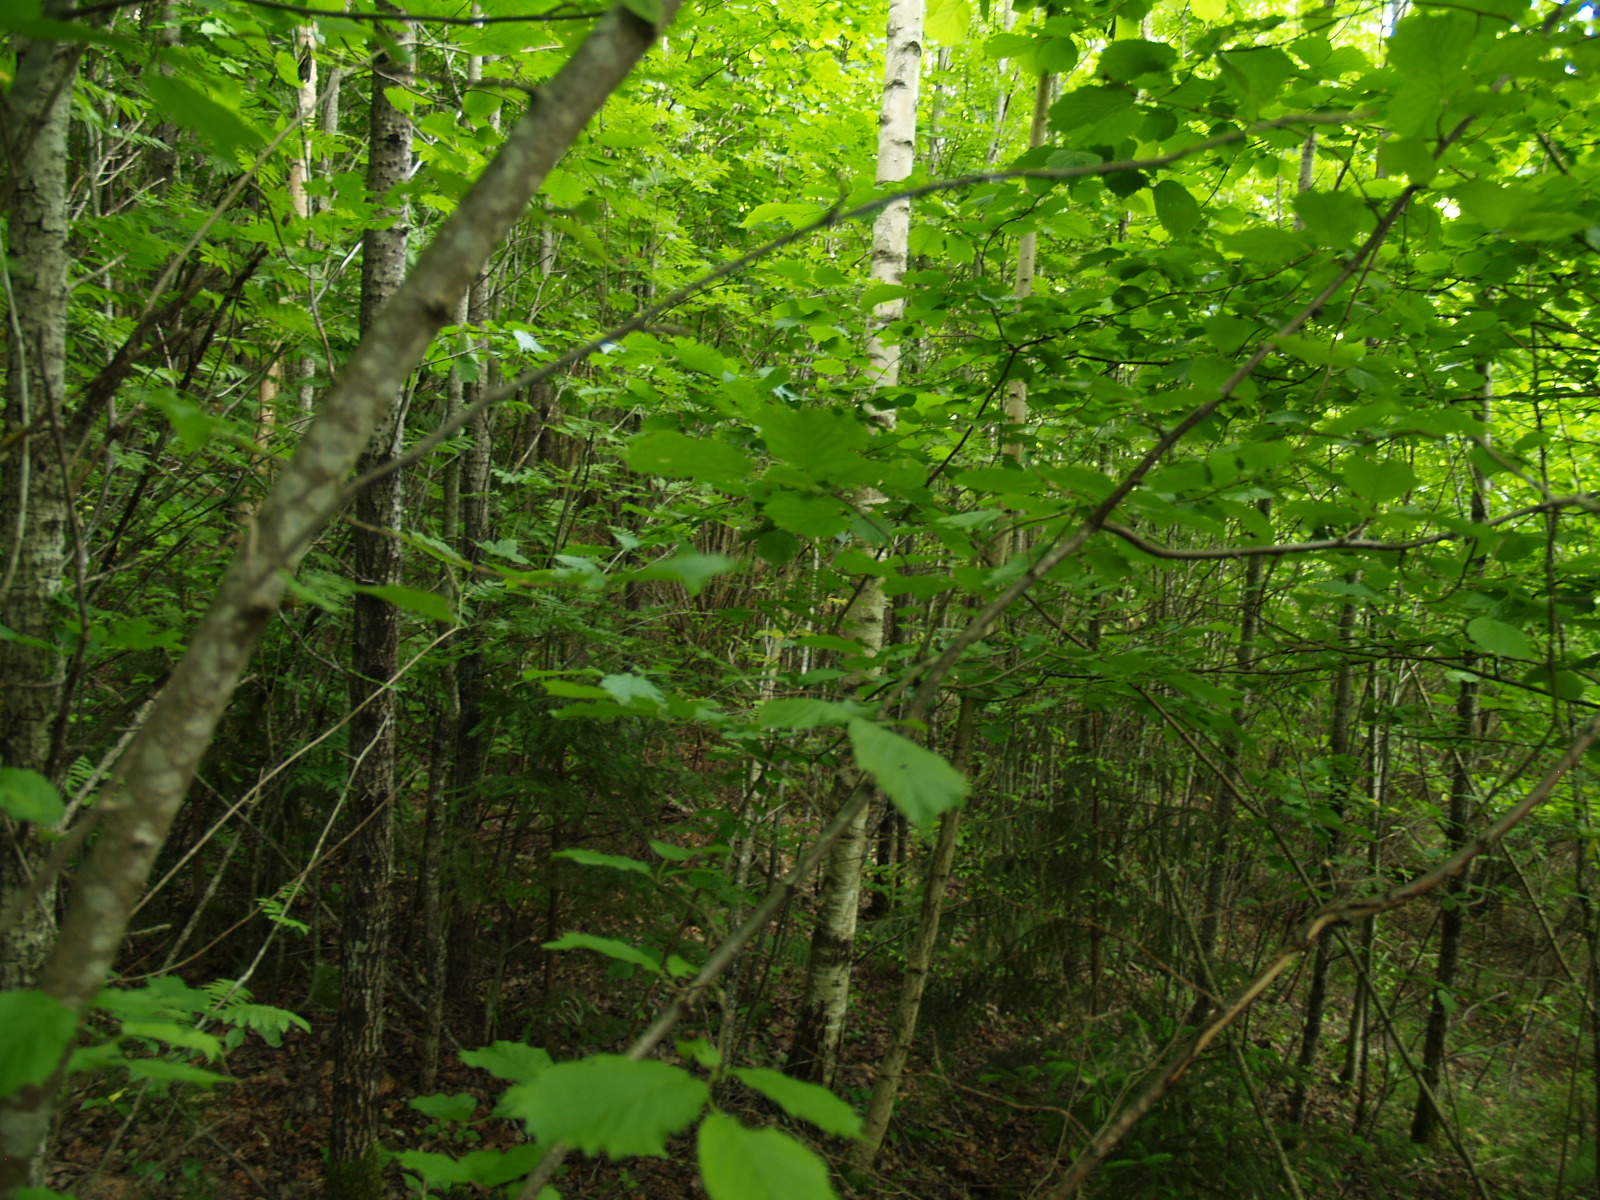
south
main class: Woodland
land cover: Broadleaved woodland
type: non-riverine alder, birch or aspen forest
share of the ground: > 75 %
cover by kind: broadleaved forest trees 100 %
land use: Forestry
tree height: > 5 m
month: June
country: LV
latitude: 56.6275
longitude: 25.6911
